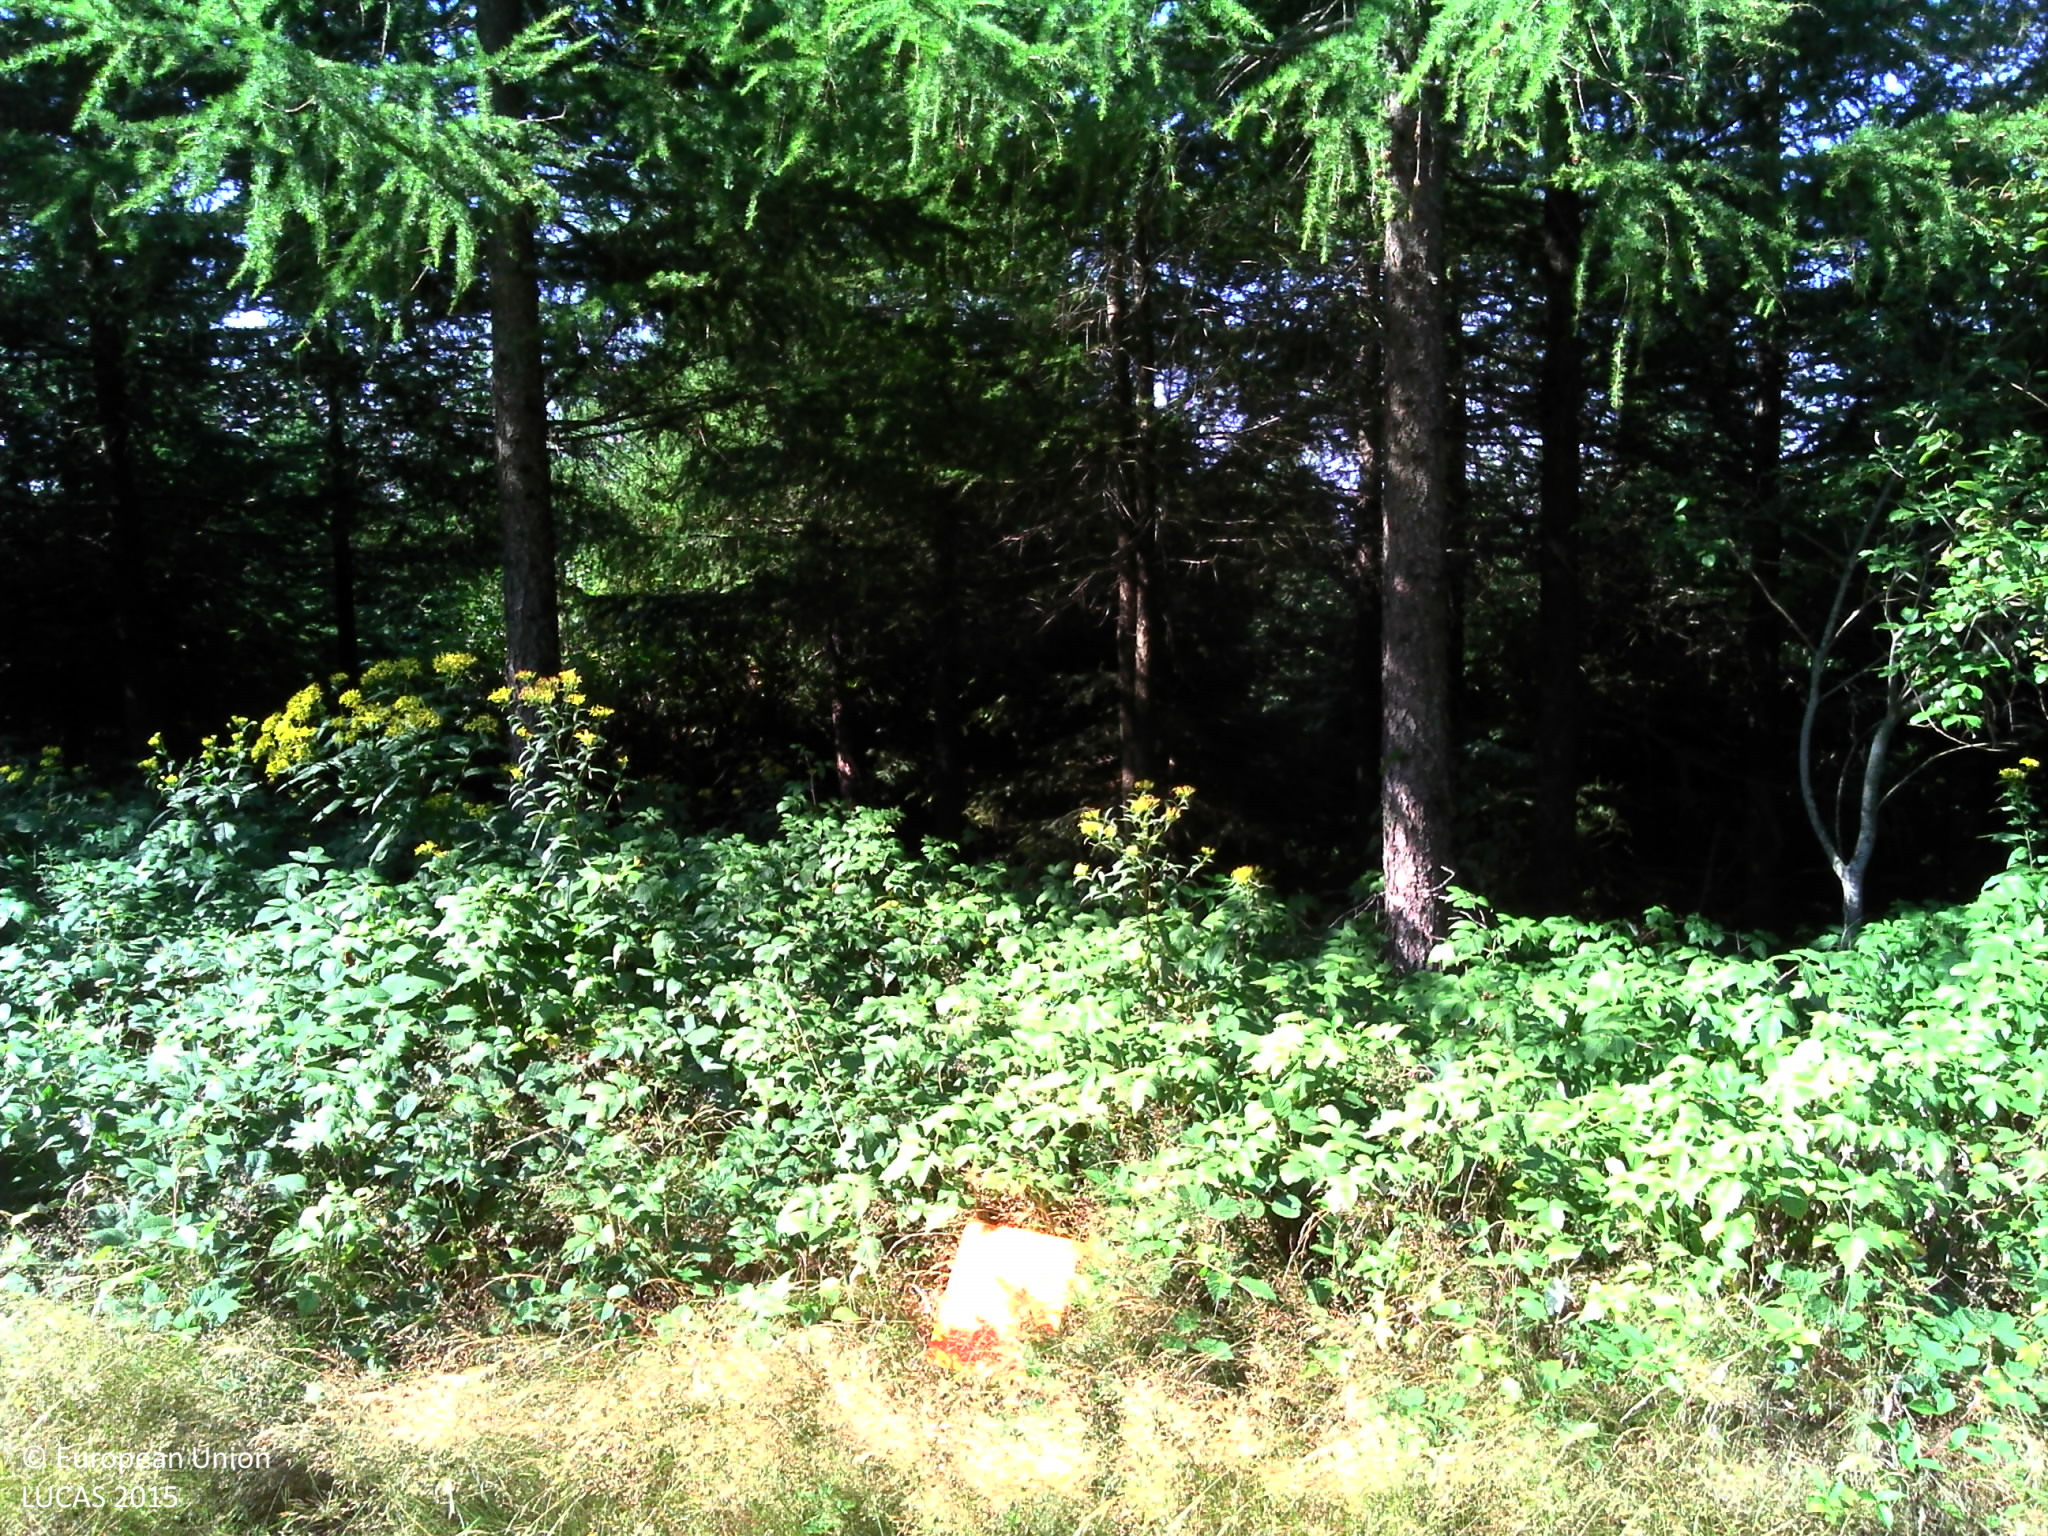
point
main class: Woodland
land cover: Other coniferous woodland
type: exotic forest
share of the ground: > 75 %
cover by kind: coniferous forest trees 65 %, herbaceous plants 25 %, shrubs 10 %
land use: Forestry
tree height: > 5 m
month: August
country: FR
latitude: 45.3651
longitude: 4.5782
